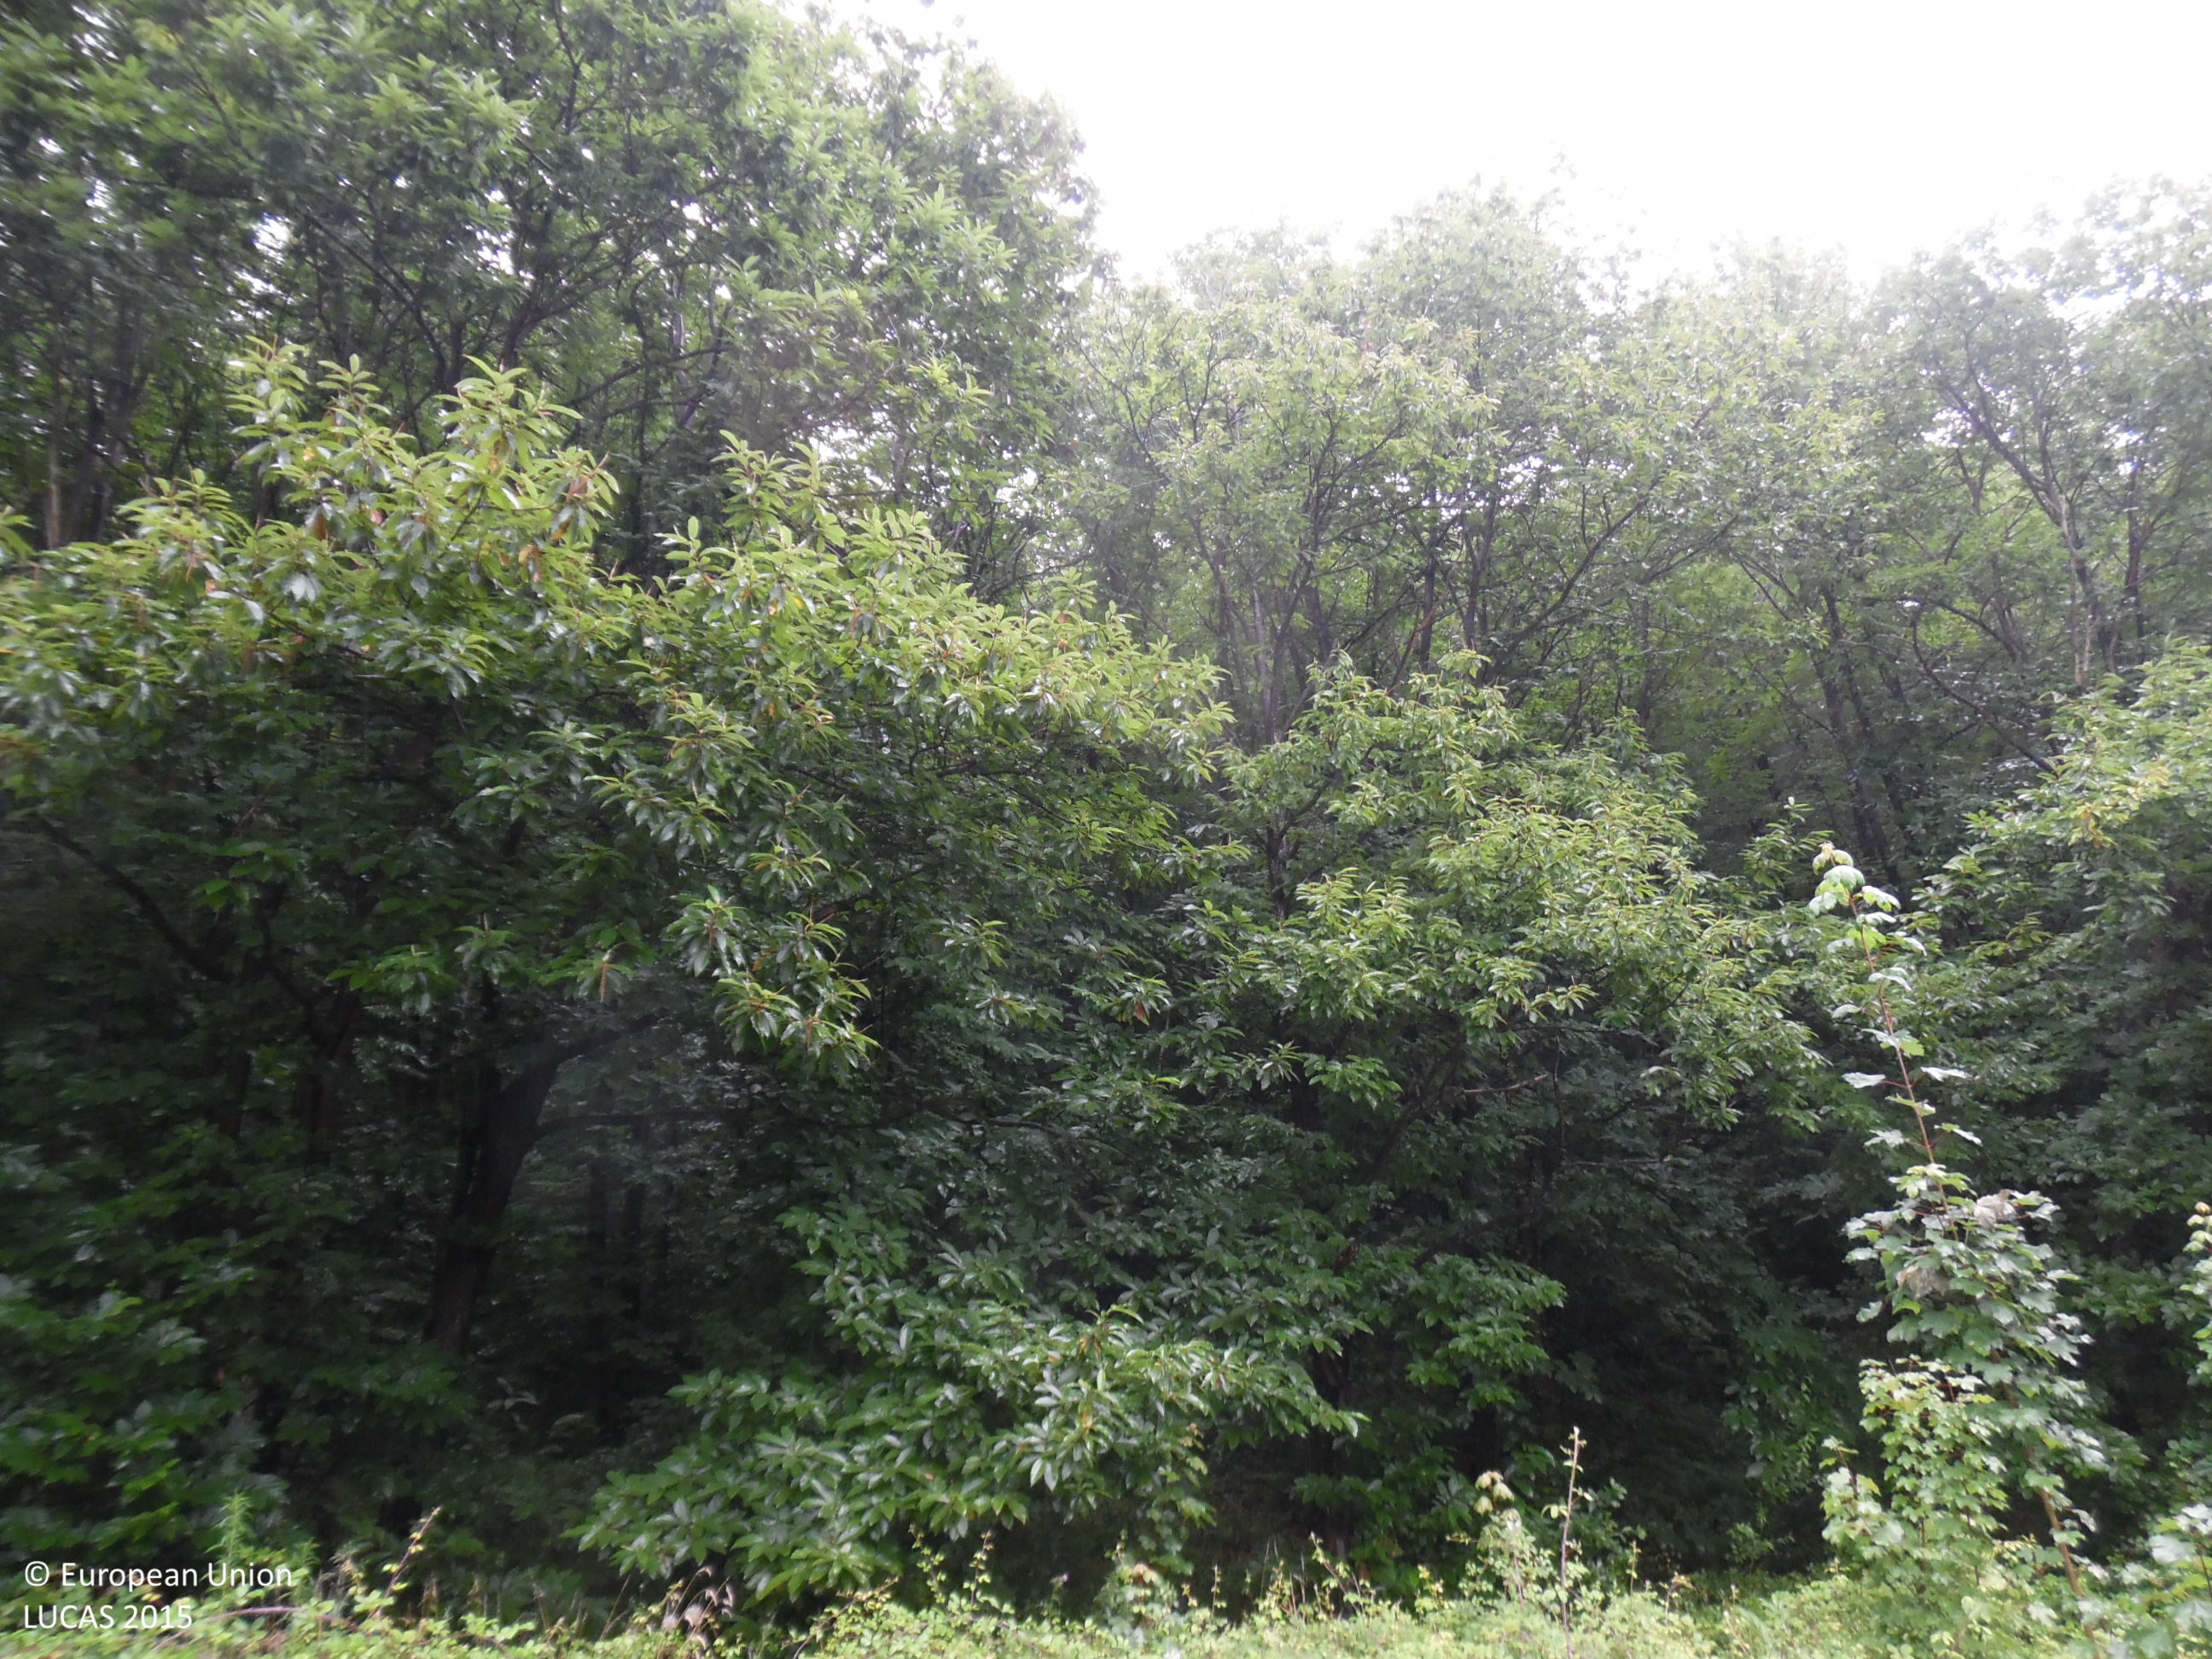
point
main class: Woodland
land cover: Broadleaved woodland
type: thermophilous deciduous forest
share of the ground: > 75 %
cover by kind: broadleaved forest trees 100 %
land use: Forestry
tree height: > 5 m
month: July
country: ES
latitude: 43.1575
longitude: -5.8643
